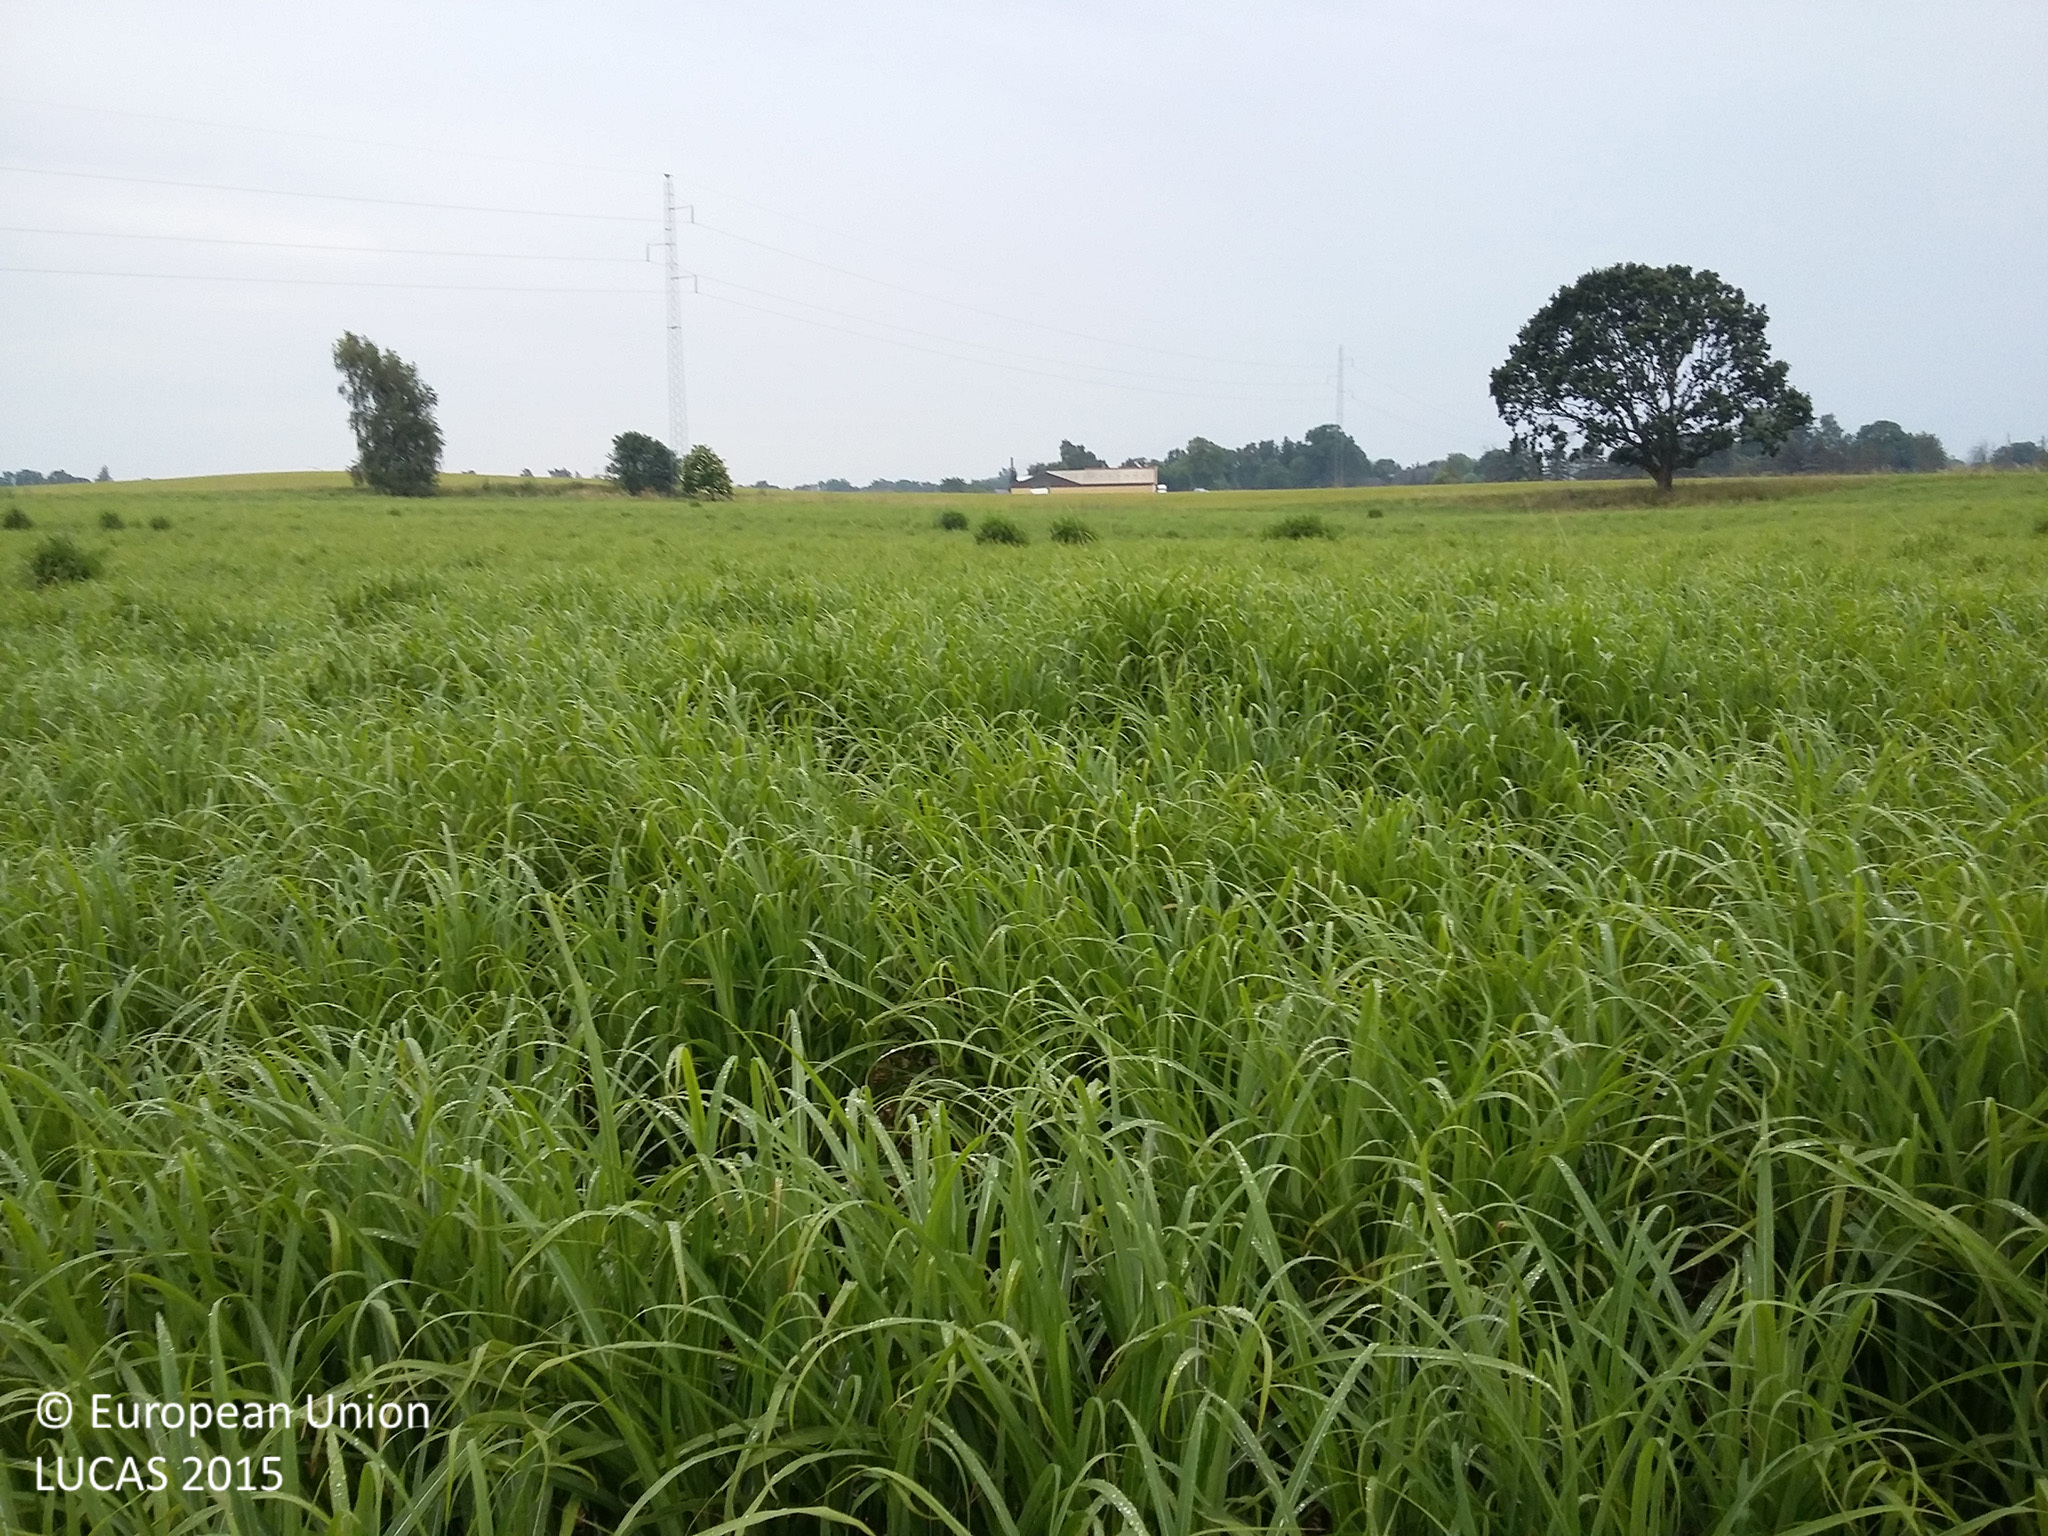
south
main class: Cropland
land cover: Permanent industrial crops
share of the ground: > 75 %
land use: Agriculture (excluding fallow land and kitchen gardens)
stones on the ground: < 10 %
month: July
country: DK
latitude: 55.2974
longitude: 11.5580
